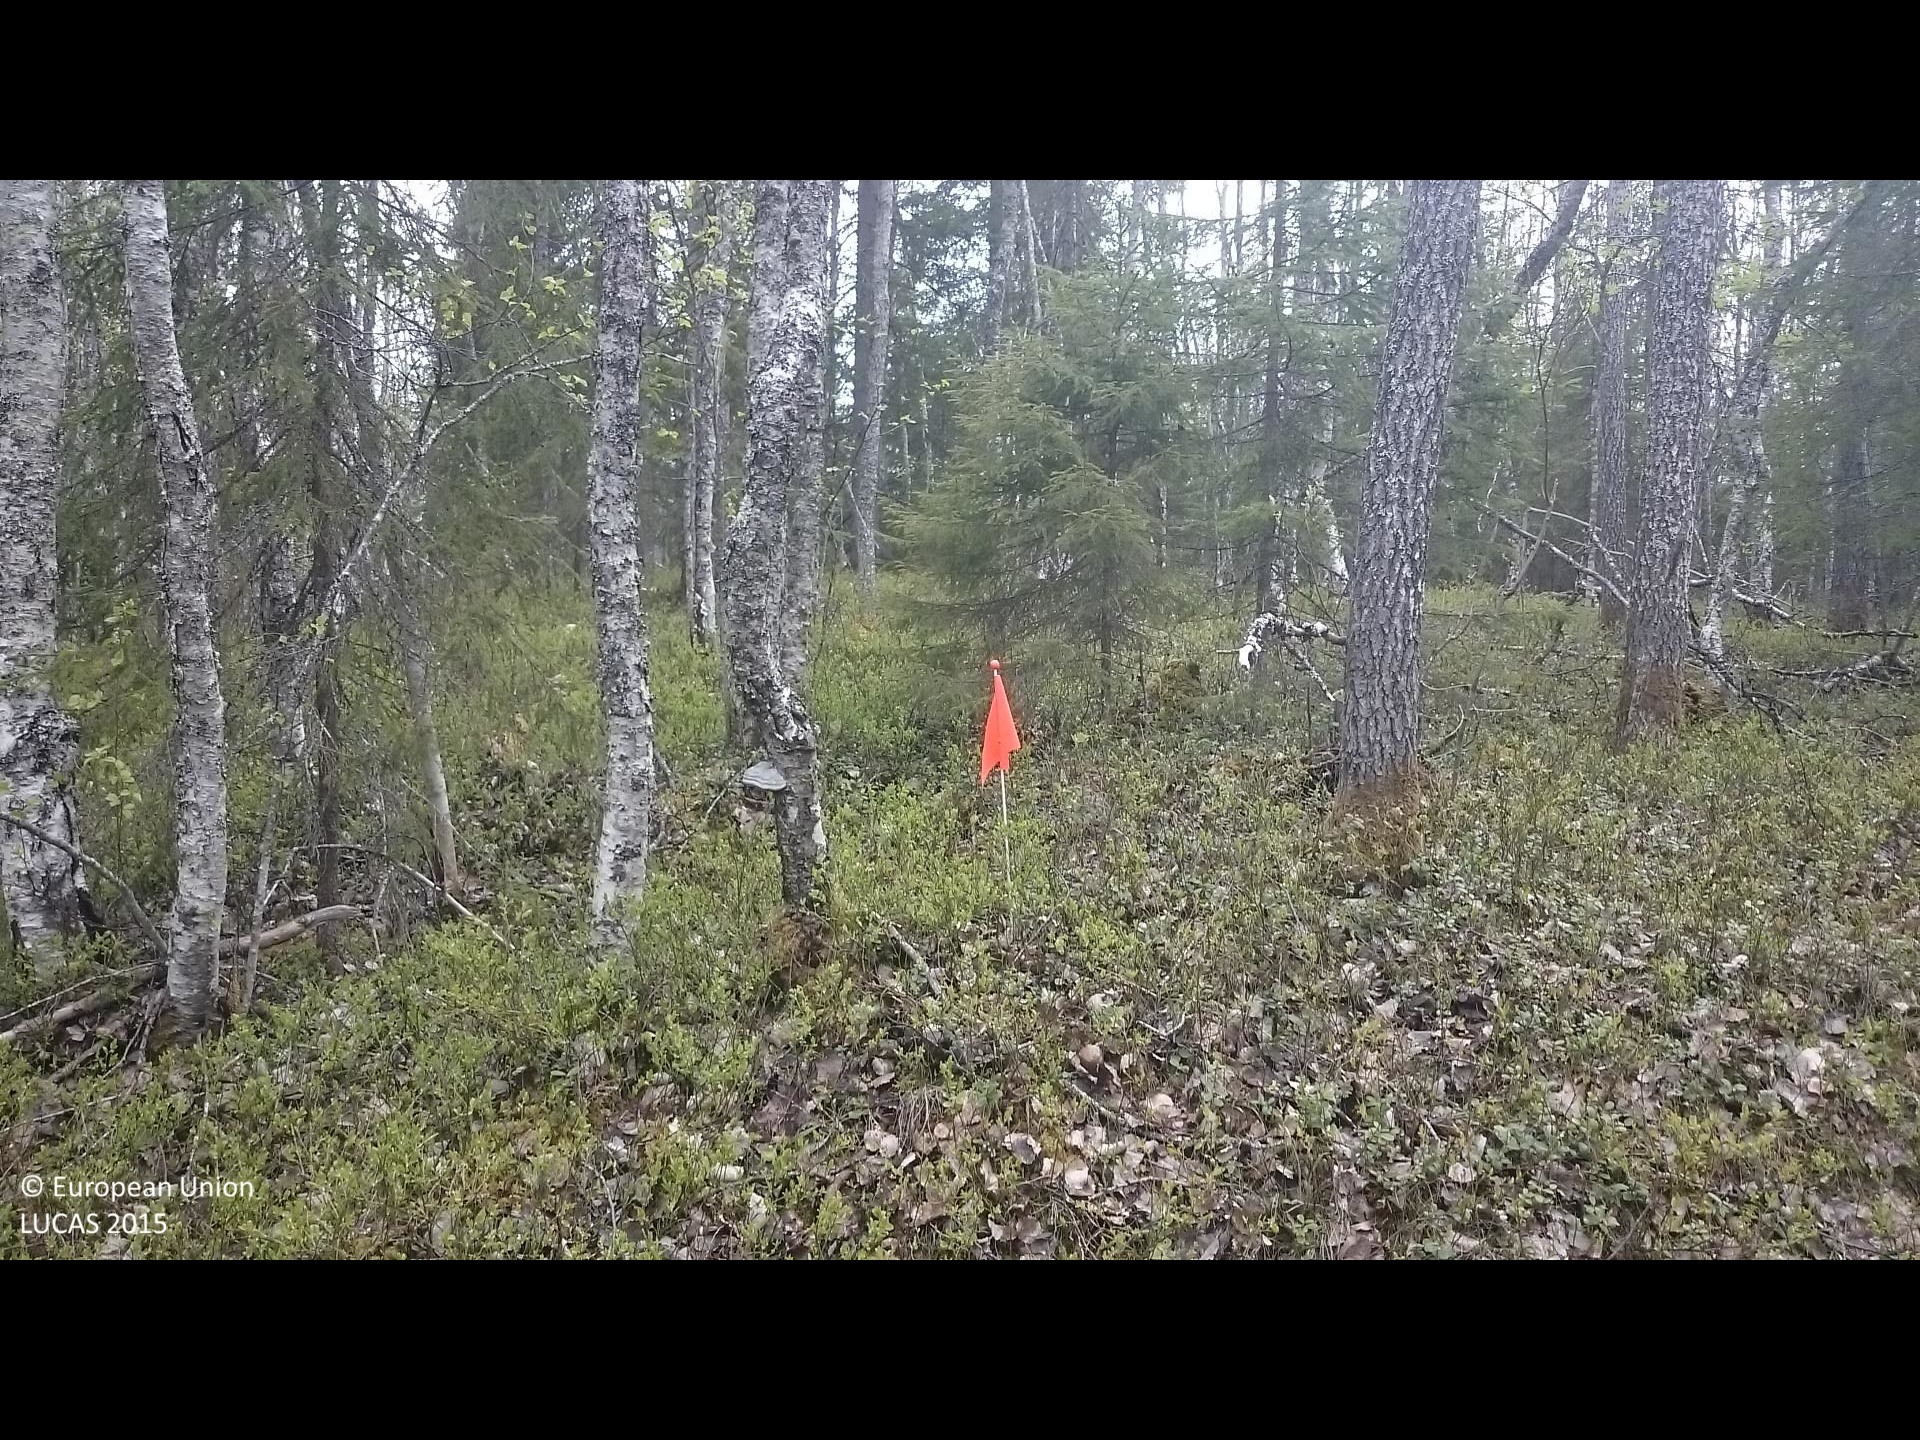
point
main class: Woodland
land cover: Spruce dominated mixed woodland
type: boreal forest
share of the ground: > 75 %
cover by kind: coniferous forest trees 60 %, broadleaved forest trees 20 %, shrubs 15 %, herbaceous plants 5 %
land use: Forestry
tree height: > 5 m
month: June
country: SE
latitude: 63.6469
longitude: 13.8363
